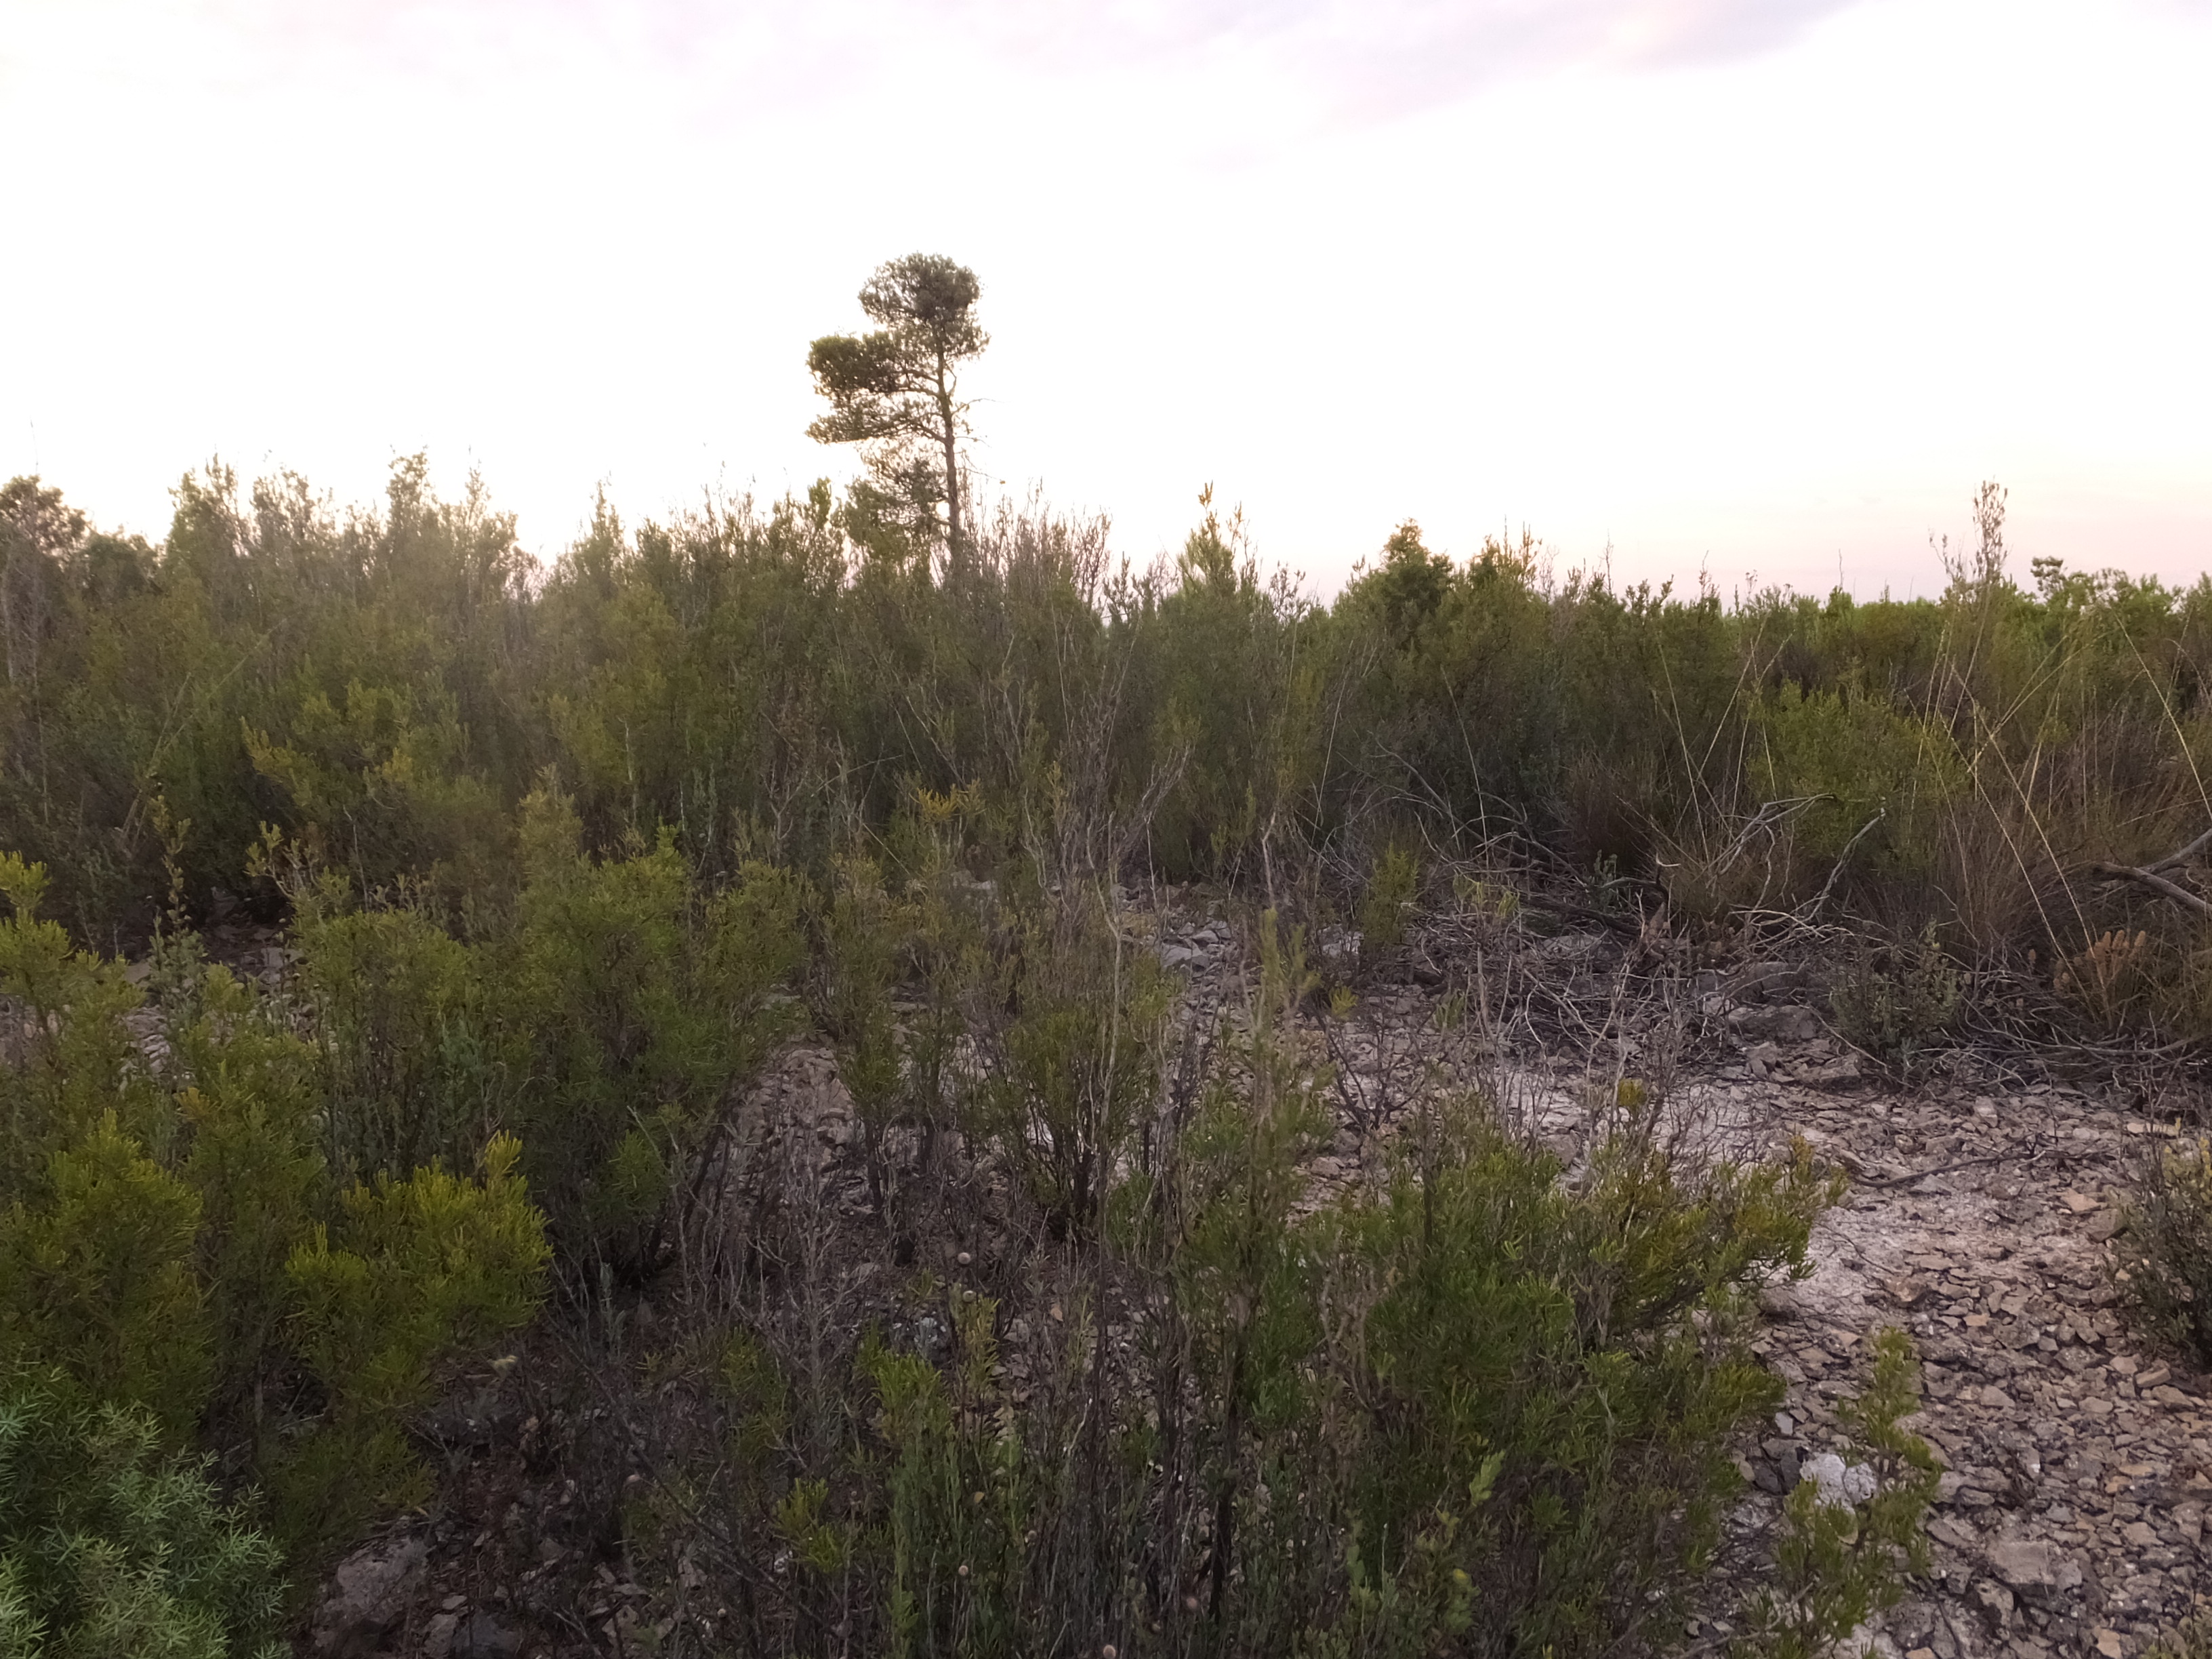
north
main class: Shrubland
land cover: Shrubland without tree cover
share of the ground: > 75 %
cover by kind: shrubs 70 %, herbaceous plants 30 %
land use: Semi-natural and natural areas not in use
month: July
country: ES
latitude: 41.1869
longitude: 0.2969
